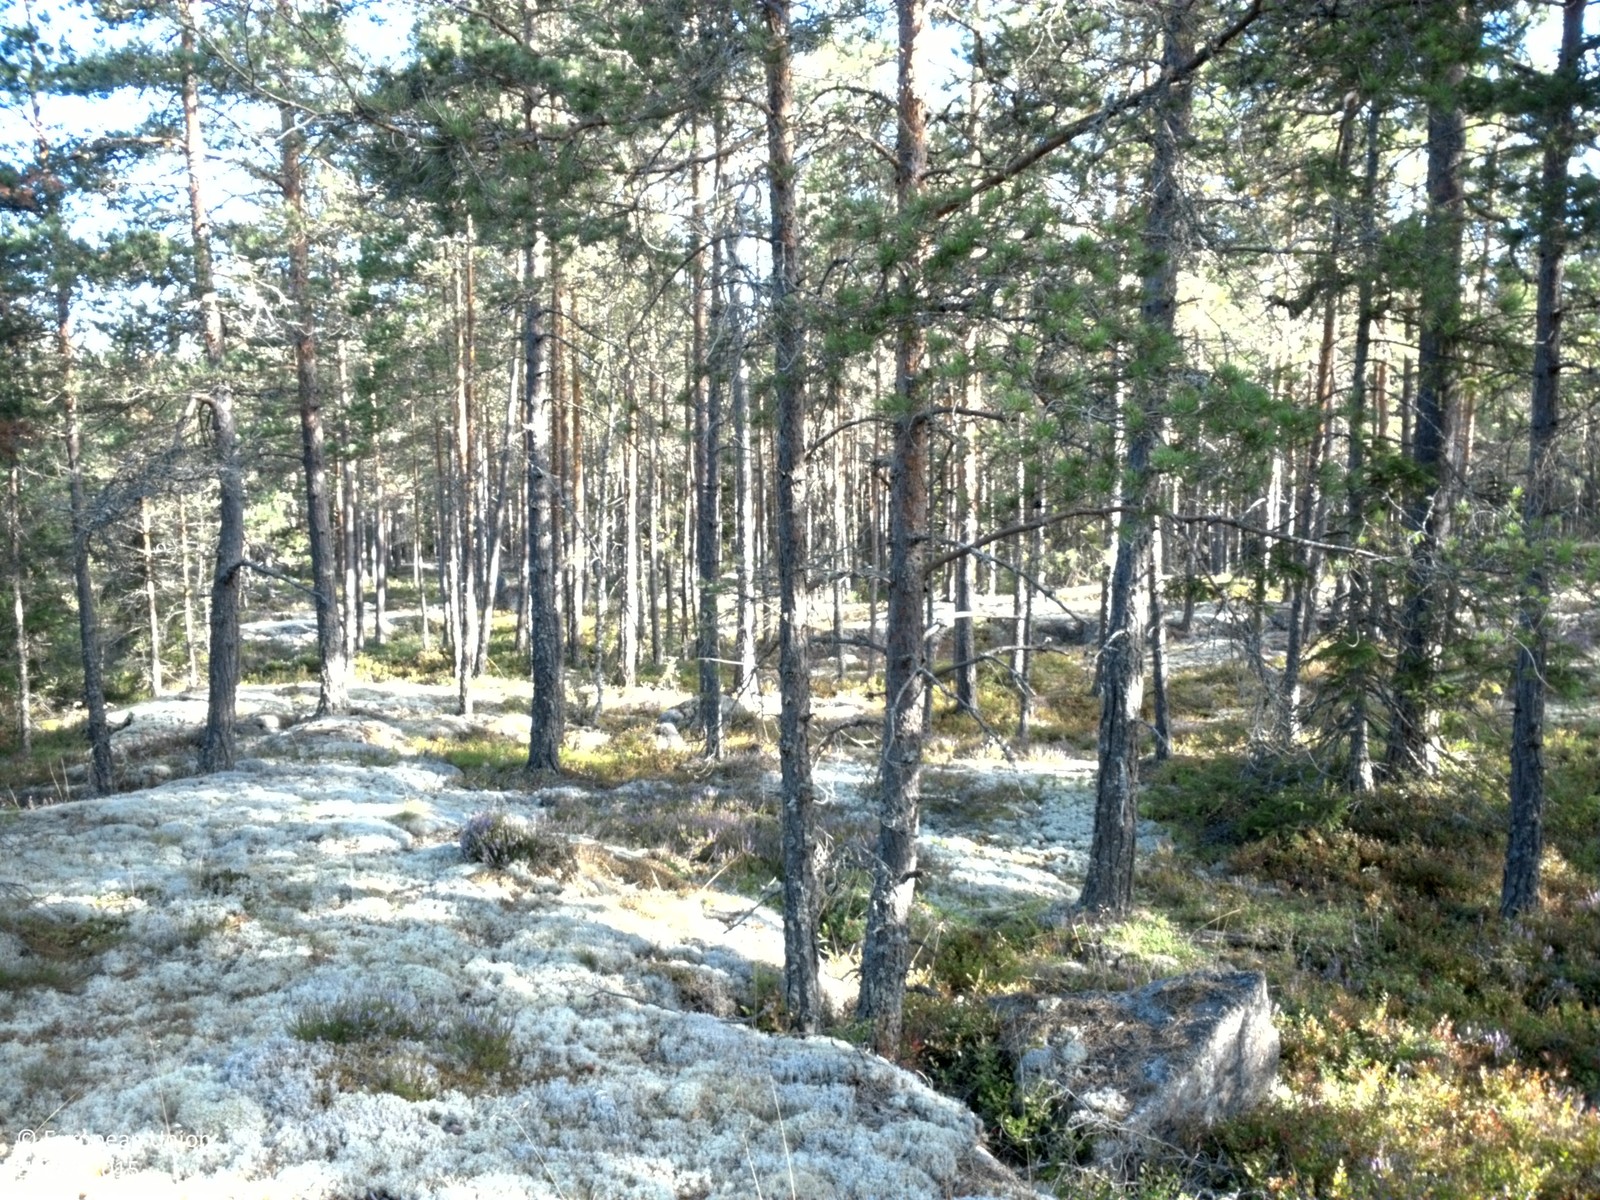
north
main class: Woodland
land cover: Pine dominated coniferous woodland
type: boreal forest
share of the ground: 25 - 50 %
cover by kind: coniferous forest trees 40 %, lichens and mosses 35 %, shrubs 25 %
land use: Forestry
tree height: > 5 m
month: August
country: SE
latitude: 59.8921
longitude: 17.1234
